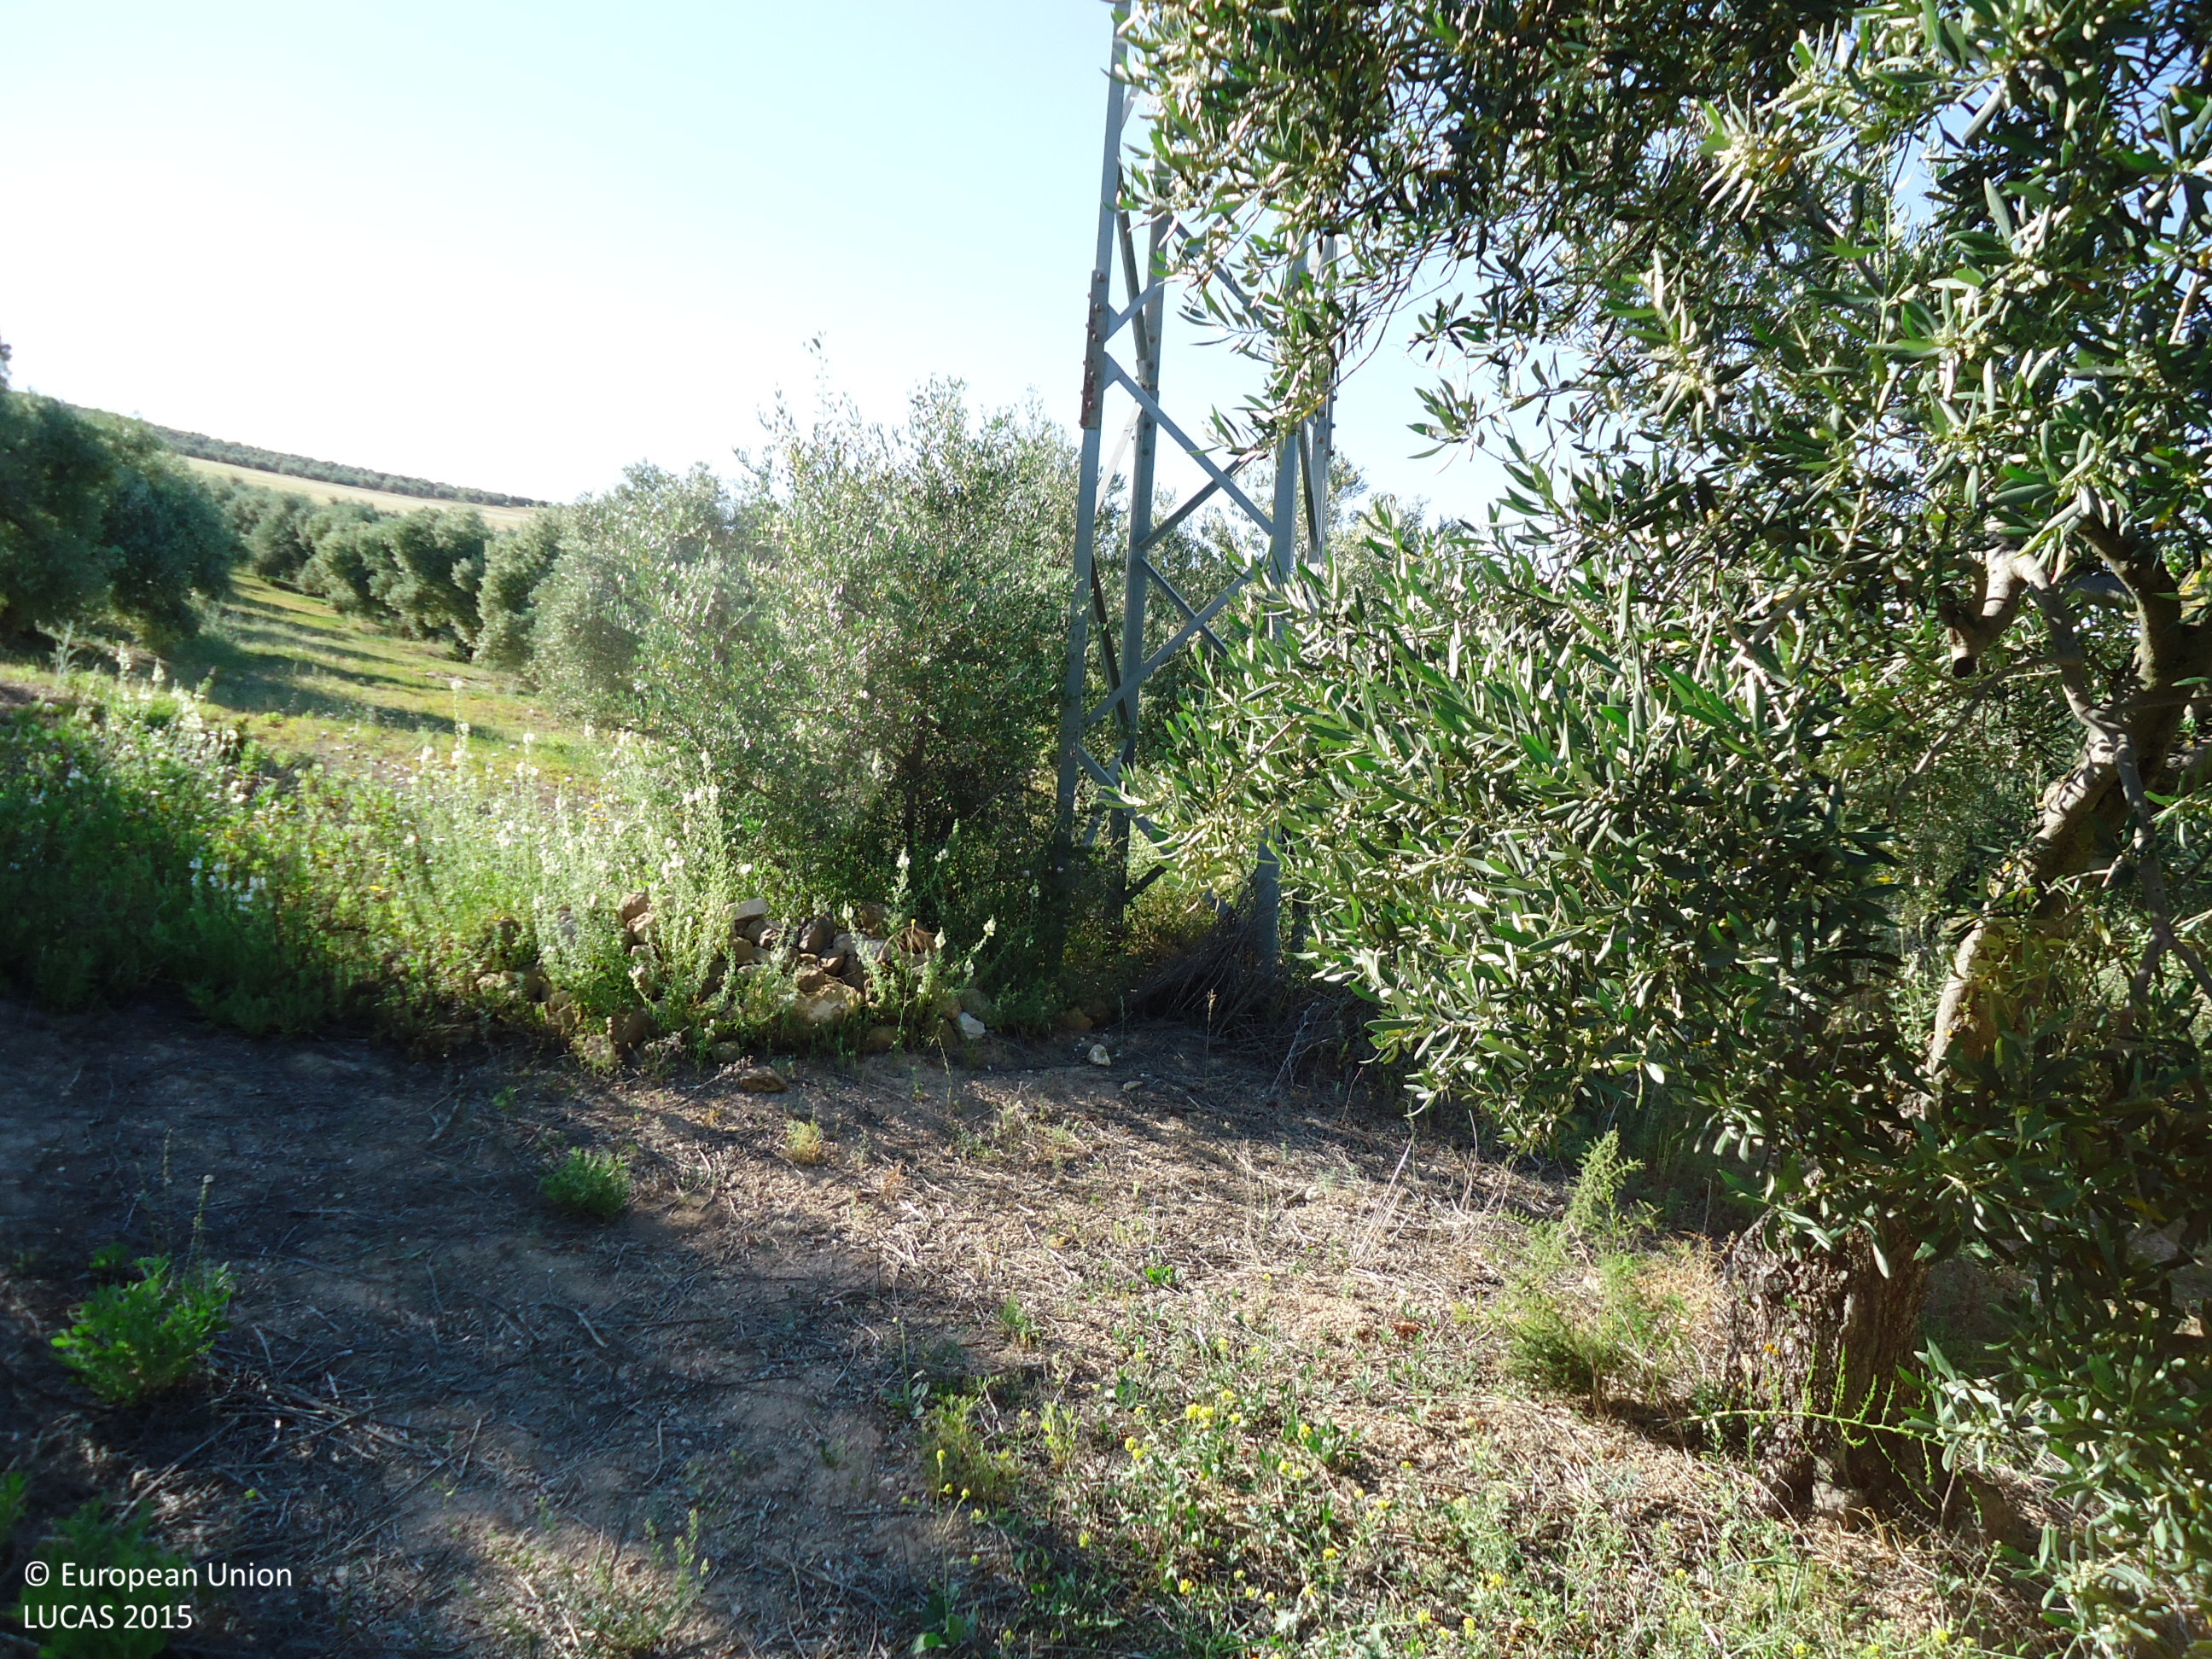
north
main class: Cropland
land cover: Olive groves
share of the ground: > 75 %
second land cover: Spontaneously vegetated surfaces
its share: 50 - 75 %
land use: Agriculture (excluding fallow land and kitchen gardens)
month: May
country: ES
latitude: 36.8817
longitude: -5.0004
